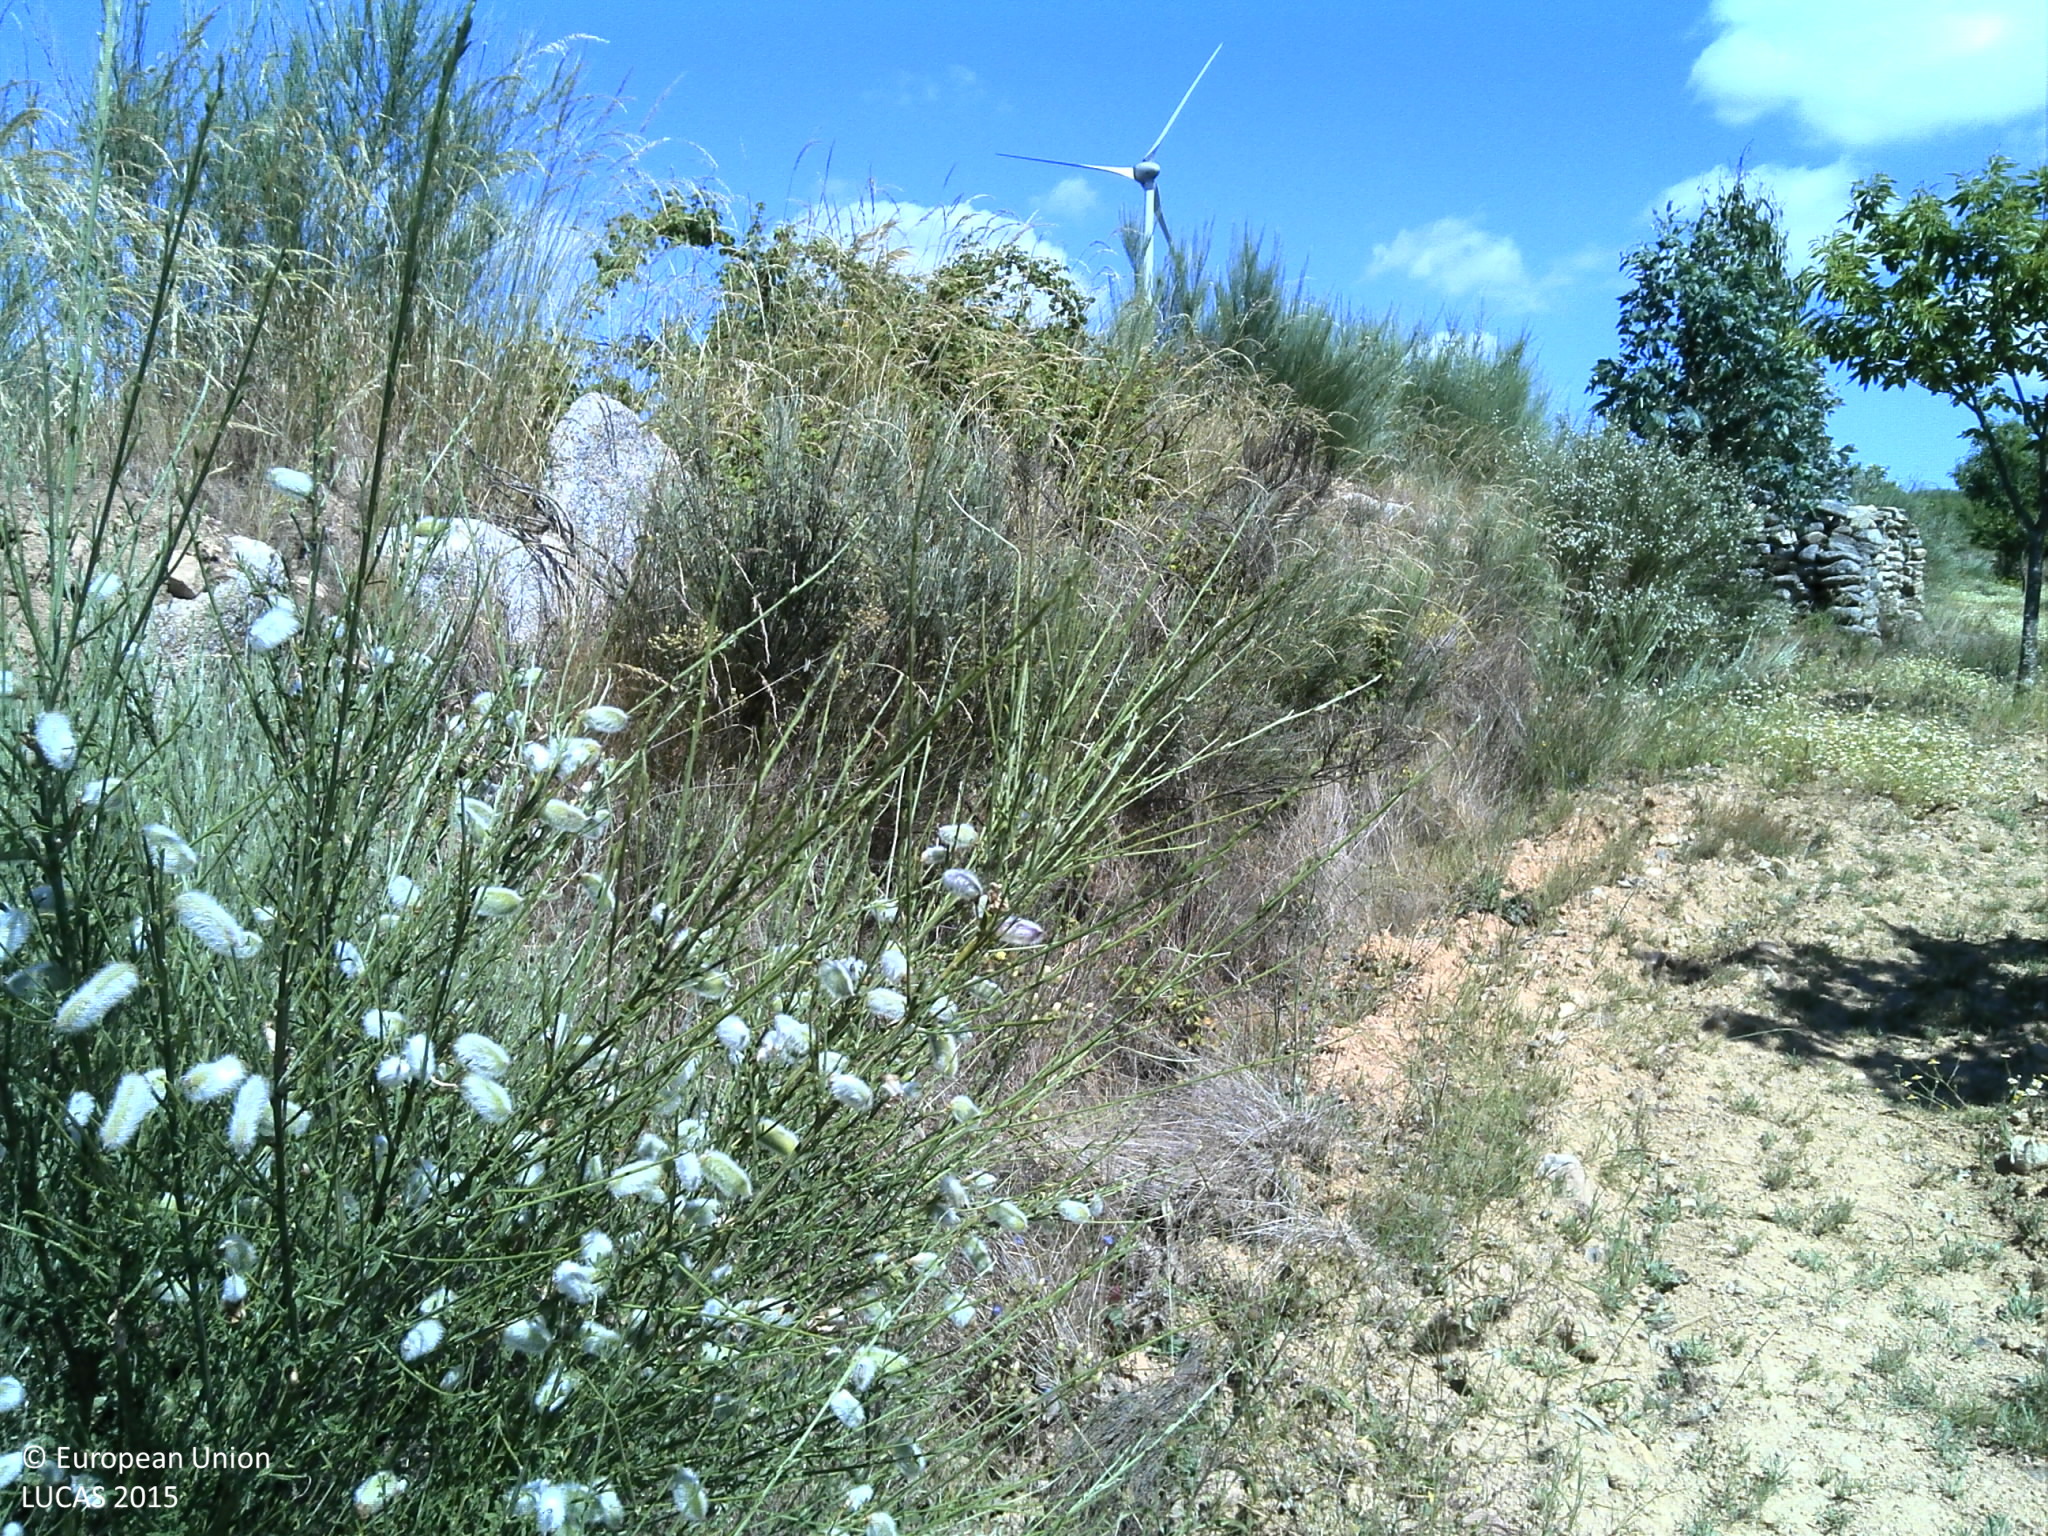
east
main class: Cropland
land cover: Nuts trees
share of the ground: < 10 %
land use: Agriculture (excluding fallow land and kitchen gardens)
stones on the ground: 10 - 25 %
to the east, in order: Nuts trees; Shruby margins; Dry stone walls; Grassland without tree/shrub cover; Shrubland without tree cover; Grass margins; Tracks; Grass margins; Shrubland without tree cover; Tracks; Shrubland without tree cover; Shrubland with sparse tree cover; Shrubland without tree cover; Grassland without tree/shrub cover; Shrubland without tree cover; Tracks; Shrubland with sparse tree cover
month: June
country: PT
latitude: 41.0518
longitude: -7.5517
